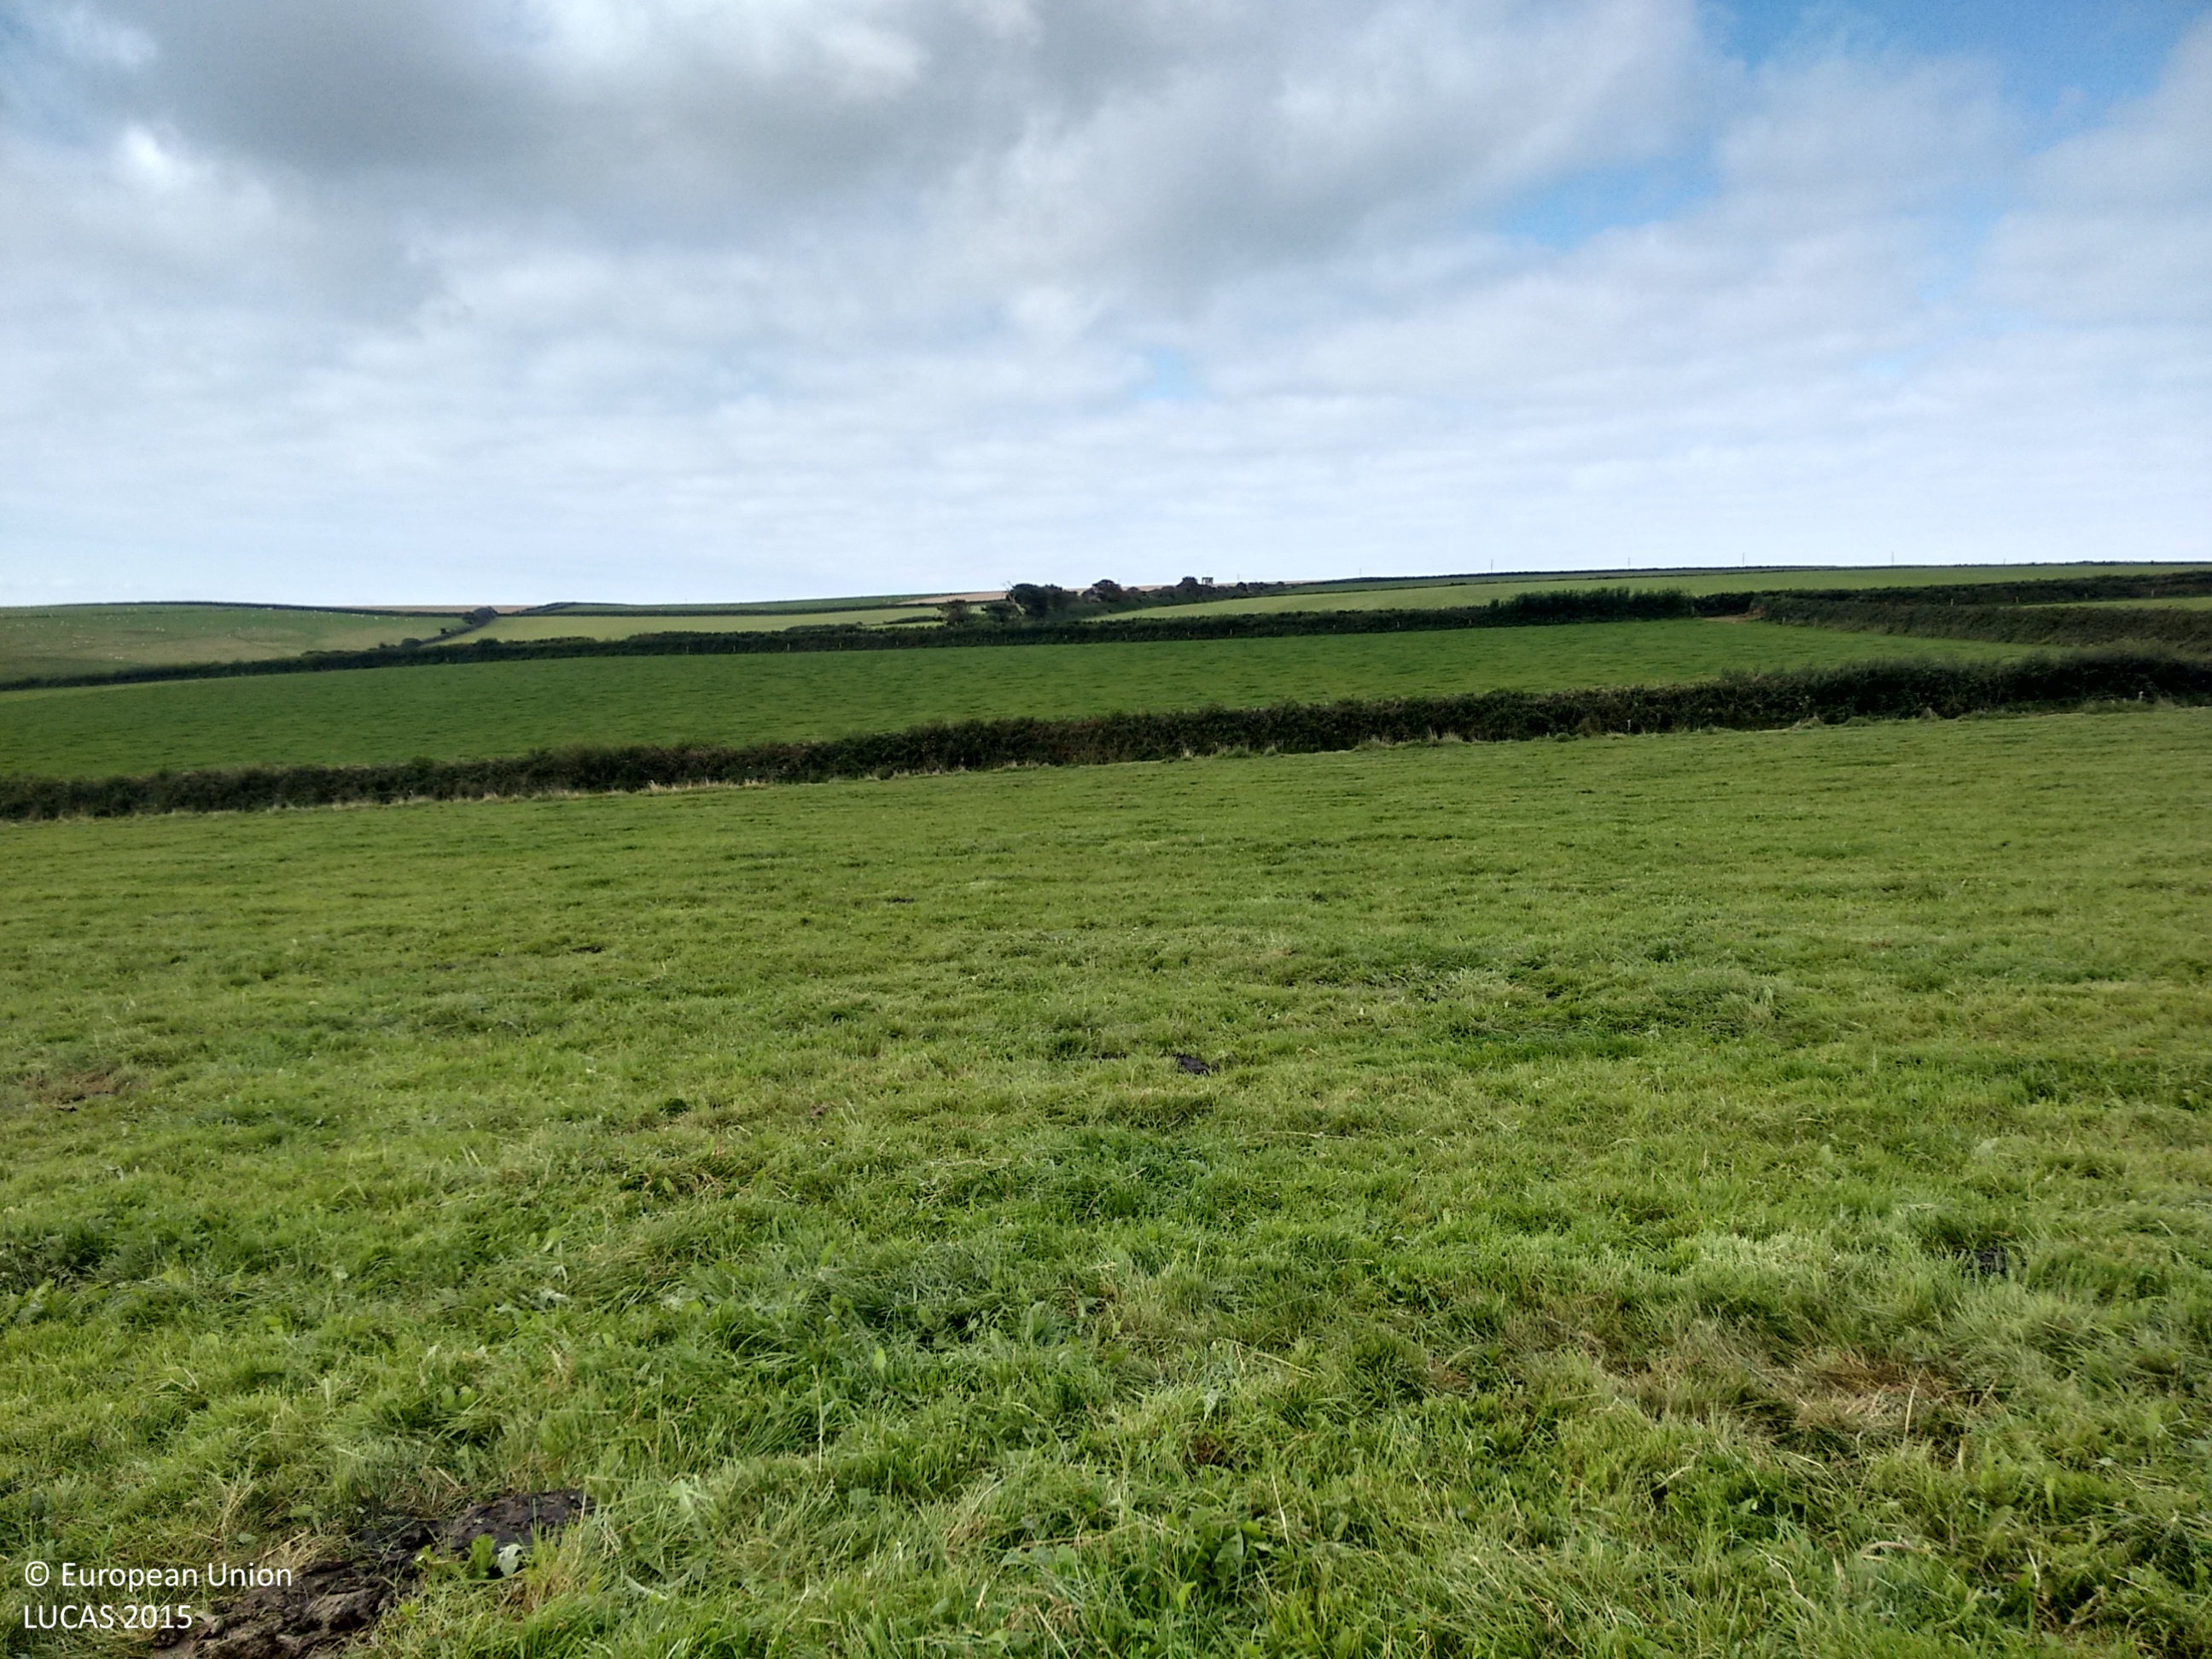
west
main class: Grassland
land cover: Grassland without tree/shrub cover
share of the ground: > 75 %
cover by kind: herbaceous plants 100 %
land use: Agriculture (excluding fallow land and kitchen gardens)
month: September
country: GB
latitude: 51.1549
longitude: -4.1812
